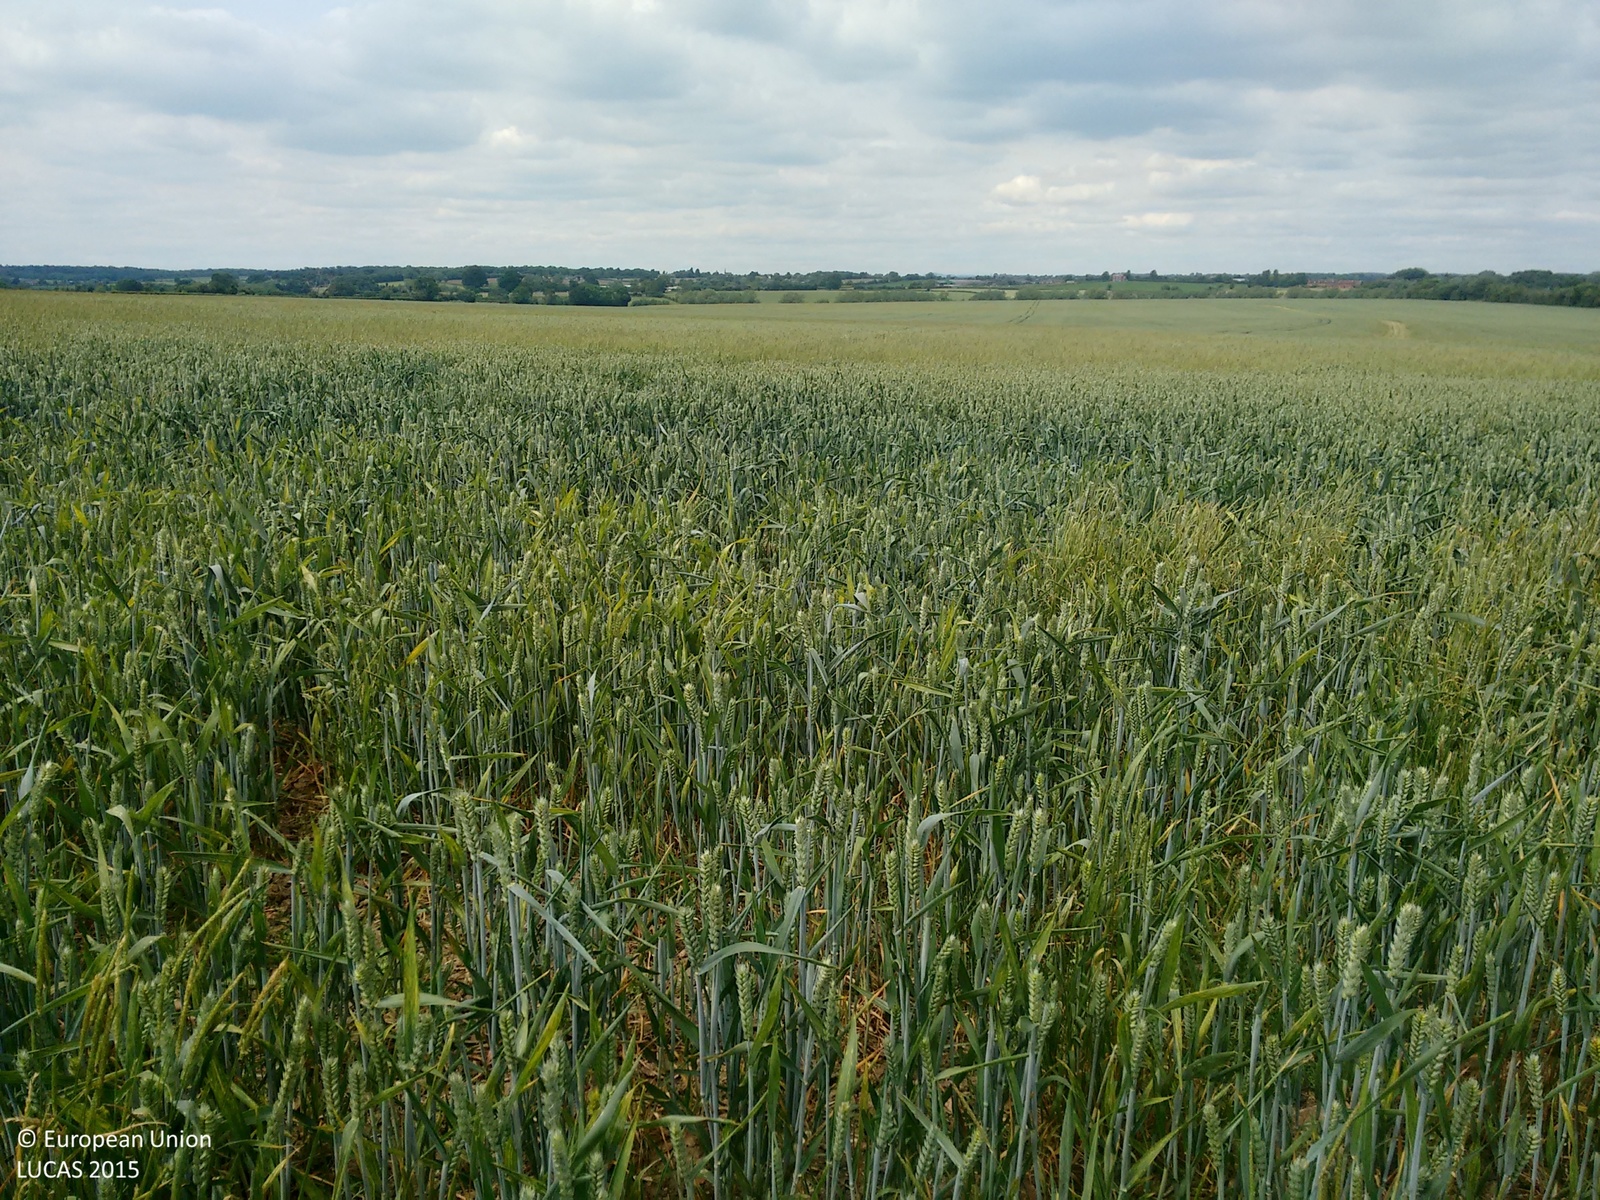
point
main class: Cropland
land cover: Common wheat
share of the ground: > 75 %
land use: Agriculture (excluding fallow land and kitchen gardens)
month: June
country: GB
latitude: 52.1215
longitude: -2.0800
